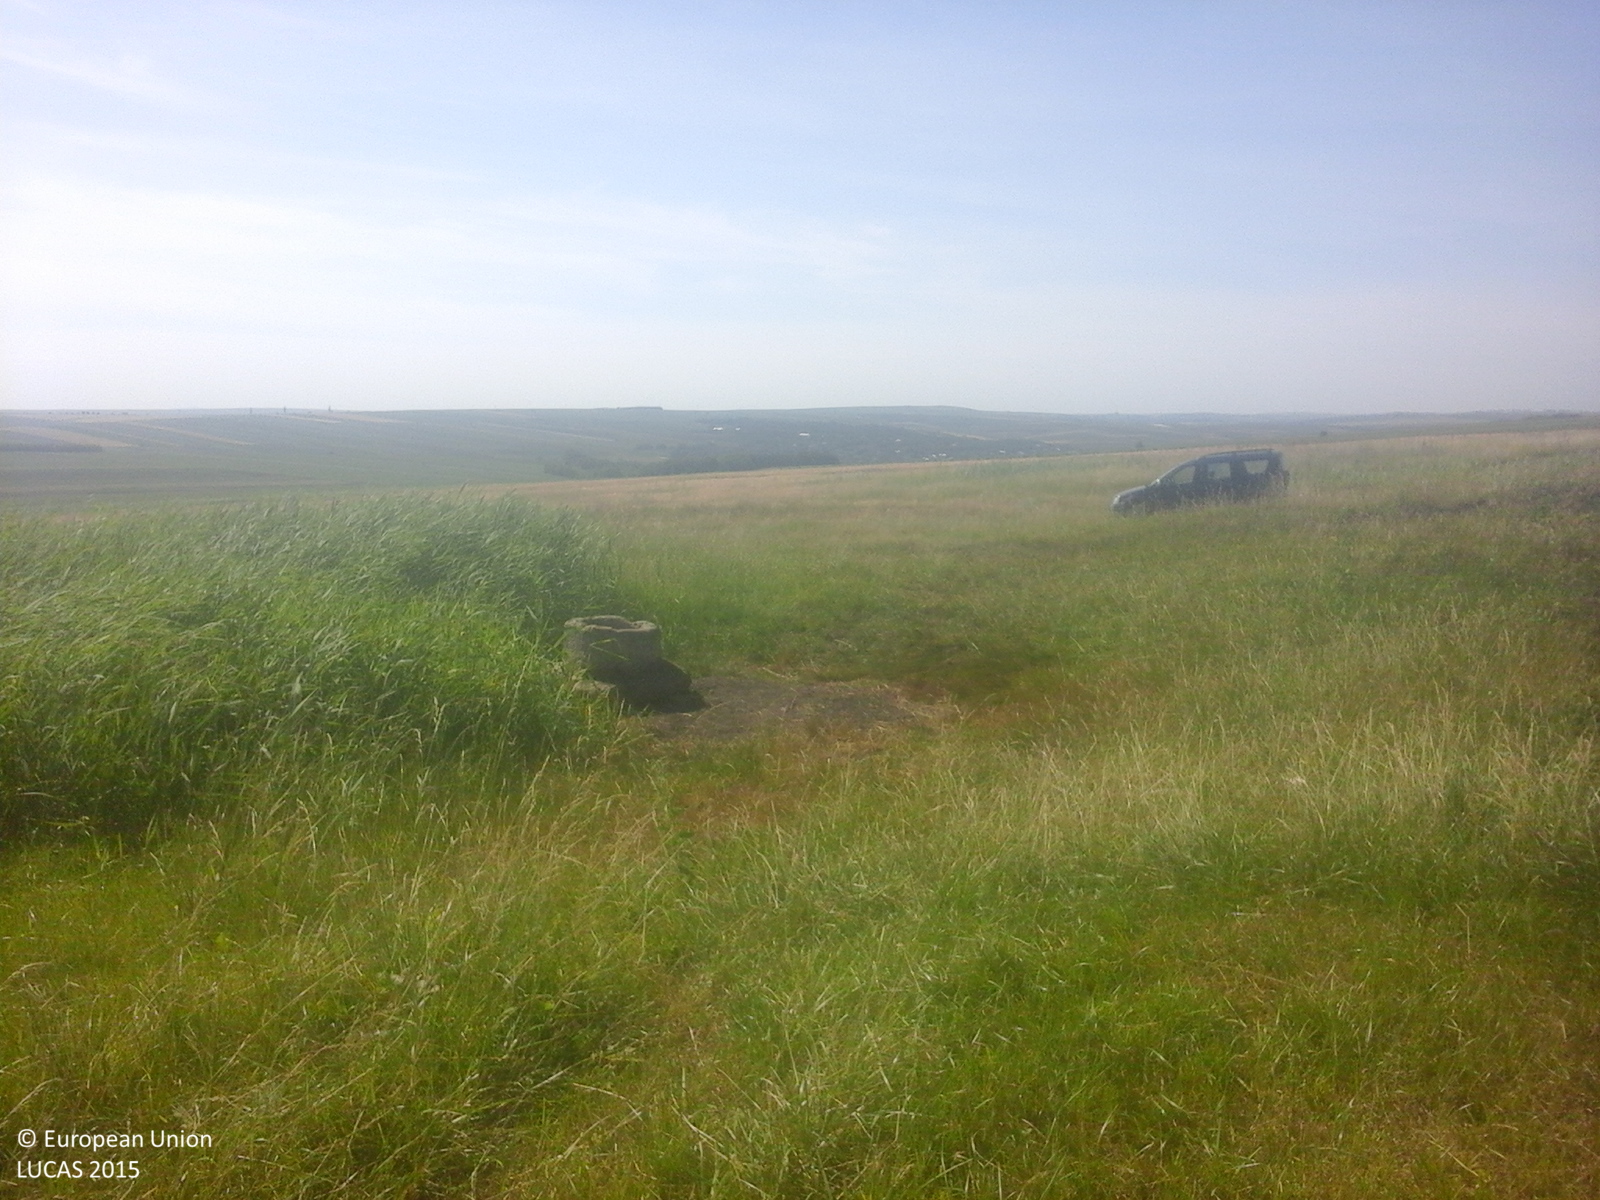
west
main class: Grassland
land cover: Grassland without tree/shrub cover
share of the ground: > 75 %
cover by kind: herbaceous plants 100 %
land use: Agriculture (excluding fallow land and kitchen gardens)
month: June
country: RO
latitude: 47.9834
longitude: 26.9464
